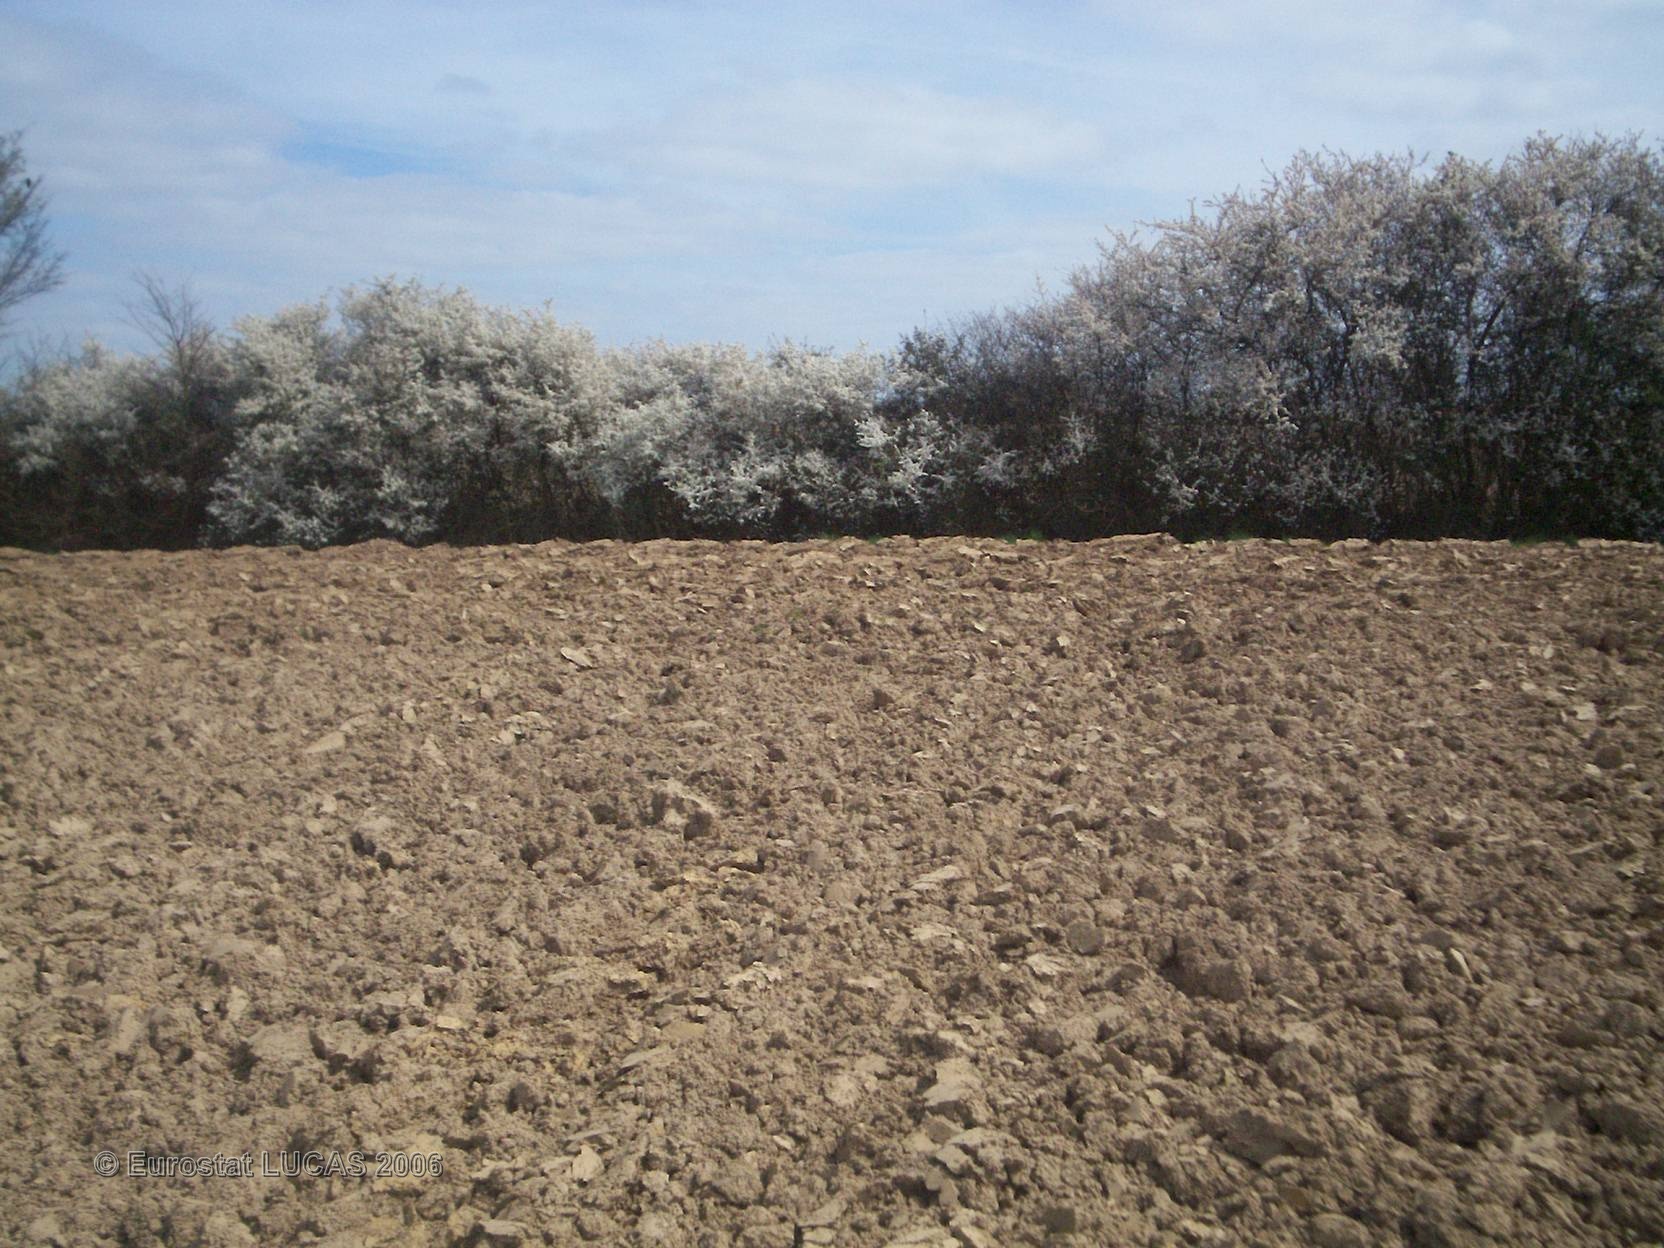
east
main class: Cropland
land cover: Maize
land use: Agriculture (excluding fallow land and kitchen gardens)
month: May
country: FR
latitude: 47.1845
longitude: 0.5712
